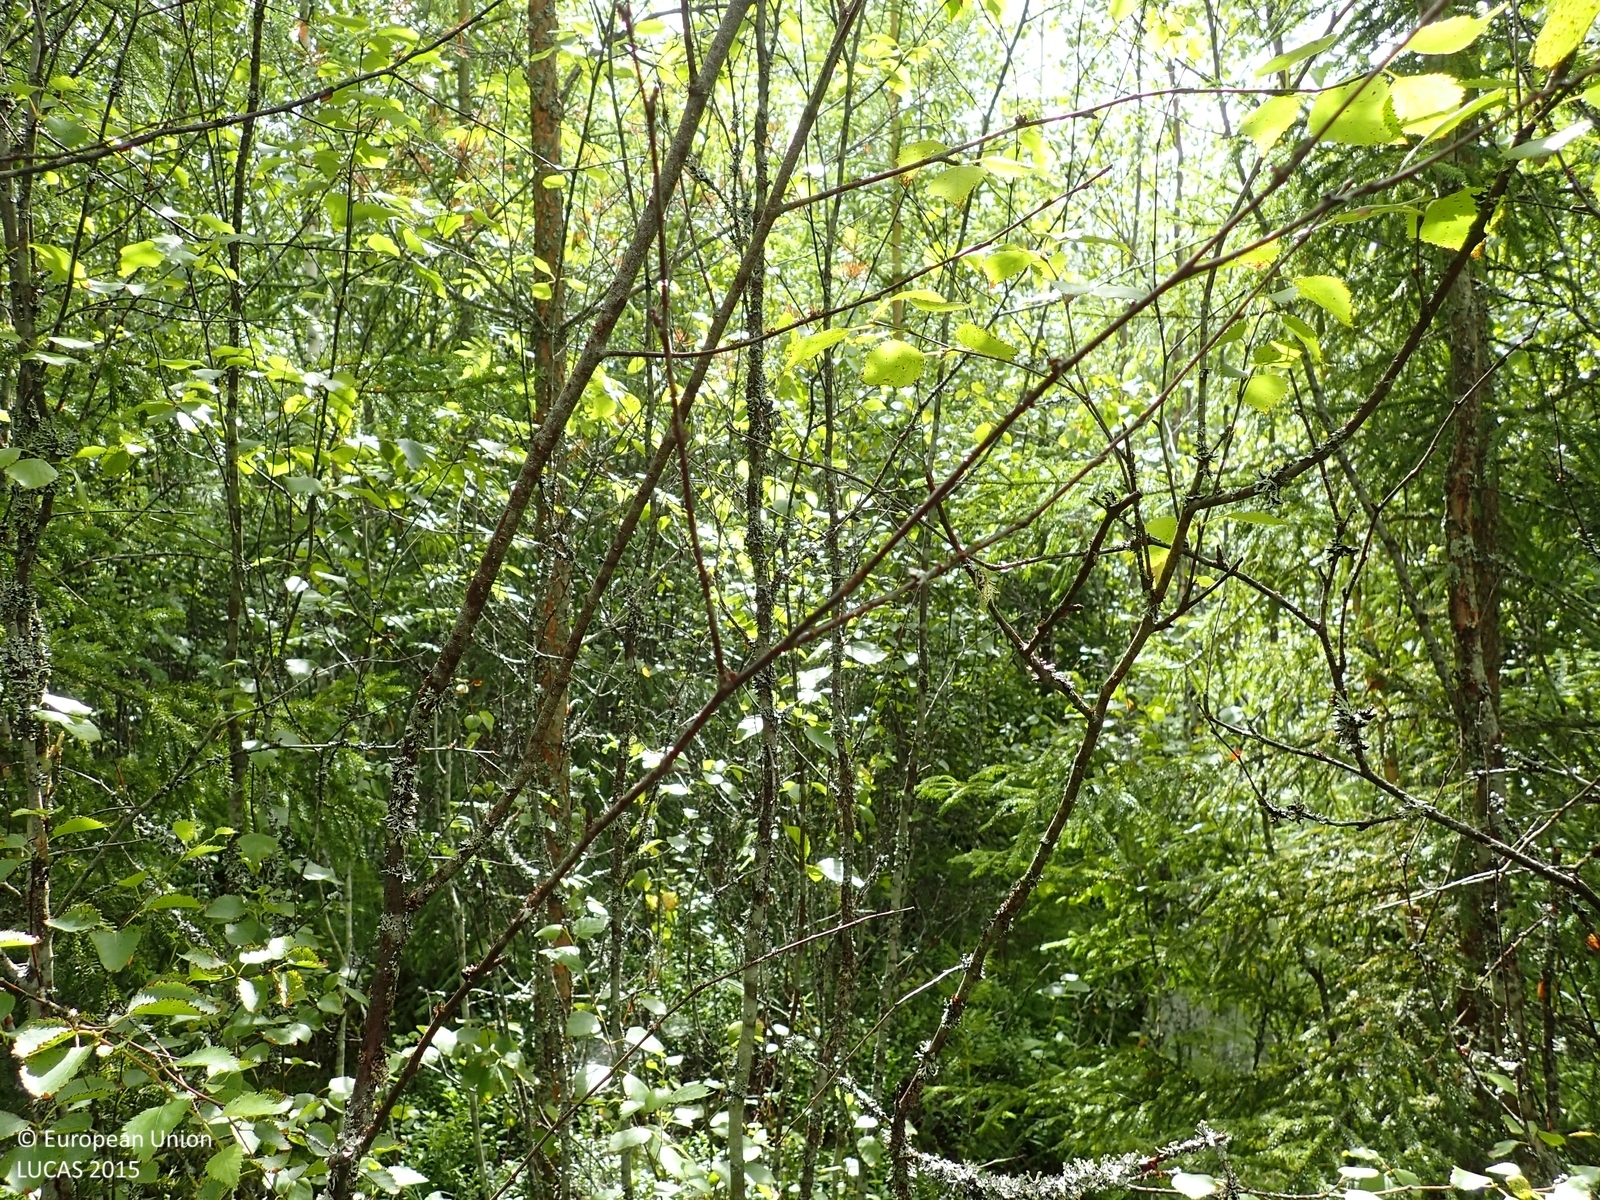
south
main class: Woodland
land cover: Broadleaved woodland
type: non-riverine alder, birch or aspen forest
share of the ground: > 75 %
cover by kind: broadleaved forest trees 80 %, coniferous forest trees 10 %, shrubs 5 %, herbaceous plants 5 %
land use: Forestry
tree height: < 5 m
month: July
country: FI
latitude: 62.8489
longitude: 22.6057
